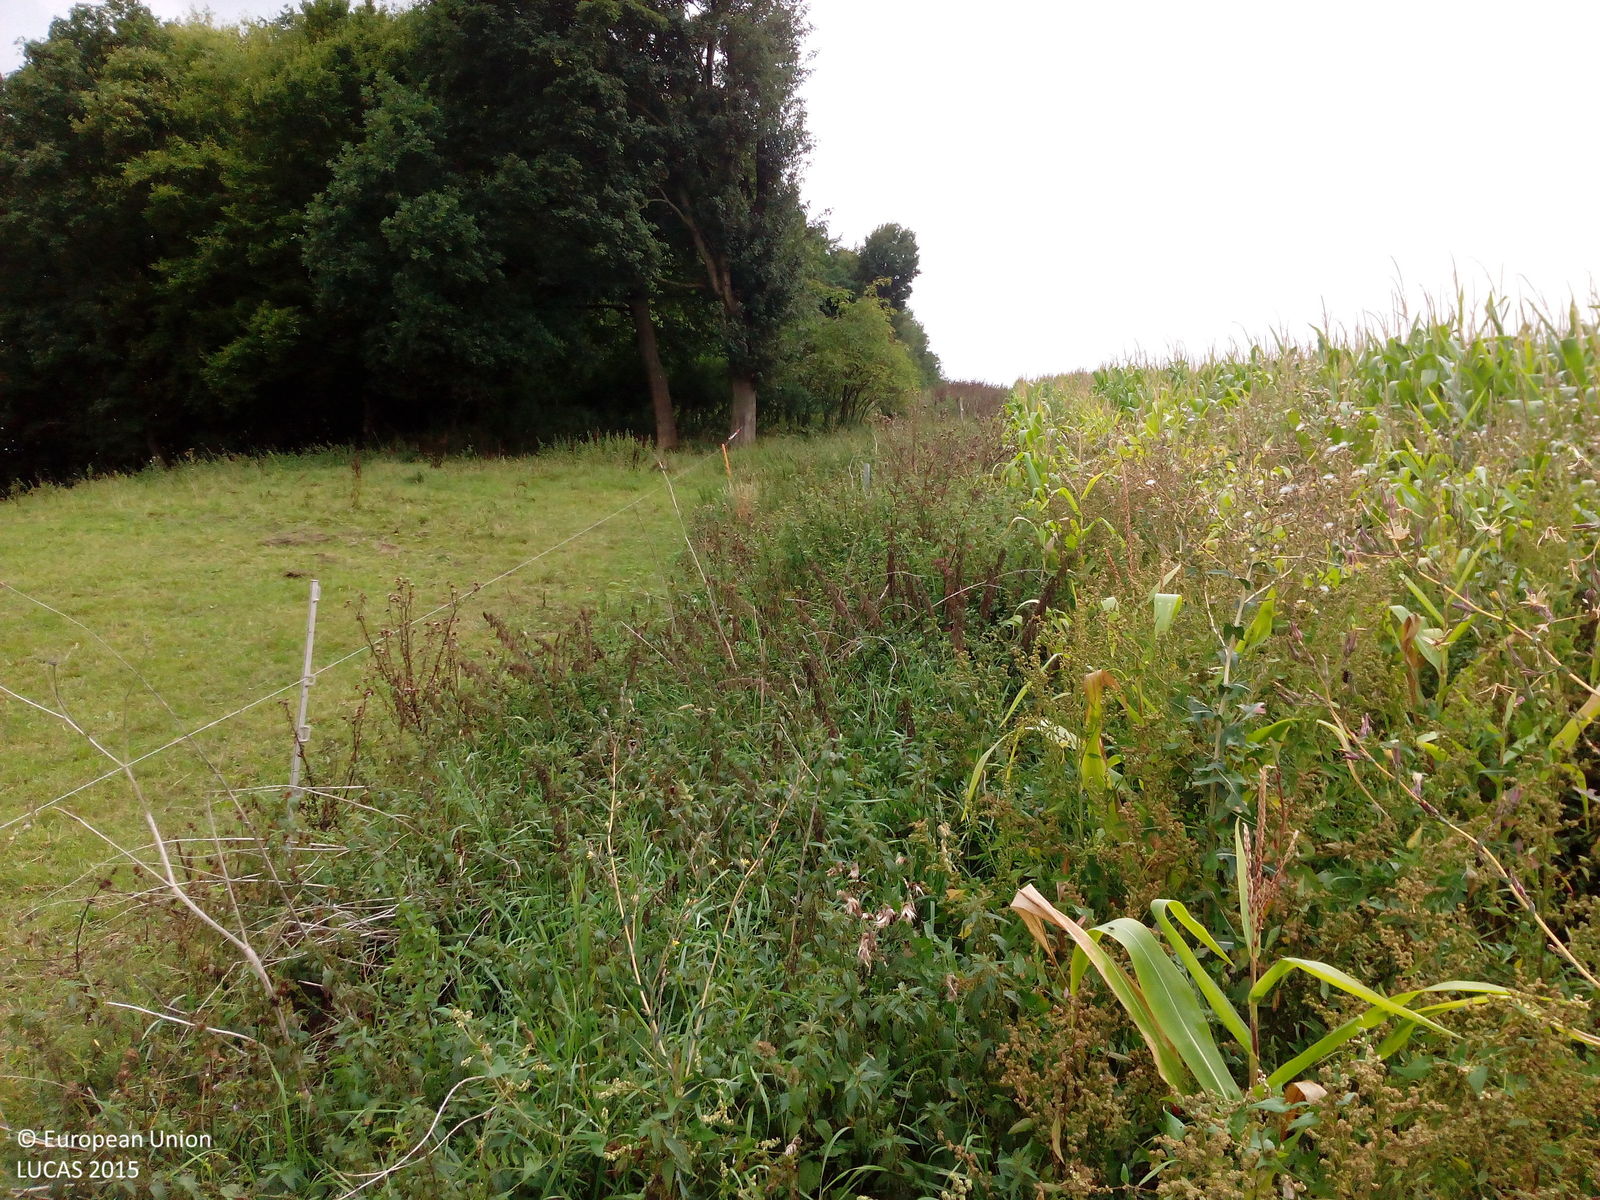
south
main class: Cropland
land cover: Maize
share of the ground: > 75 %
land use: Agriculture (excluding fallow land and kitchen gardens)
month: August
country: DE
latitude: 50.9211
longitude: 10.2702
